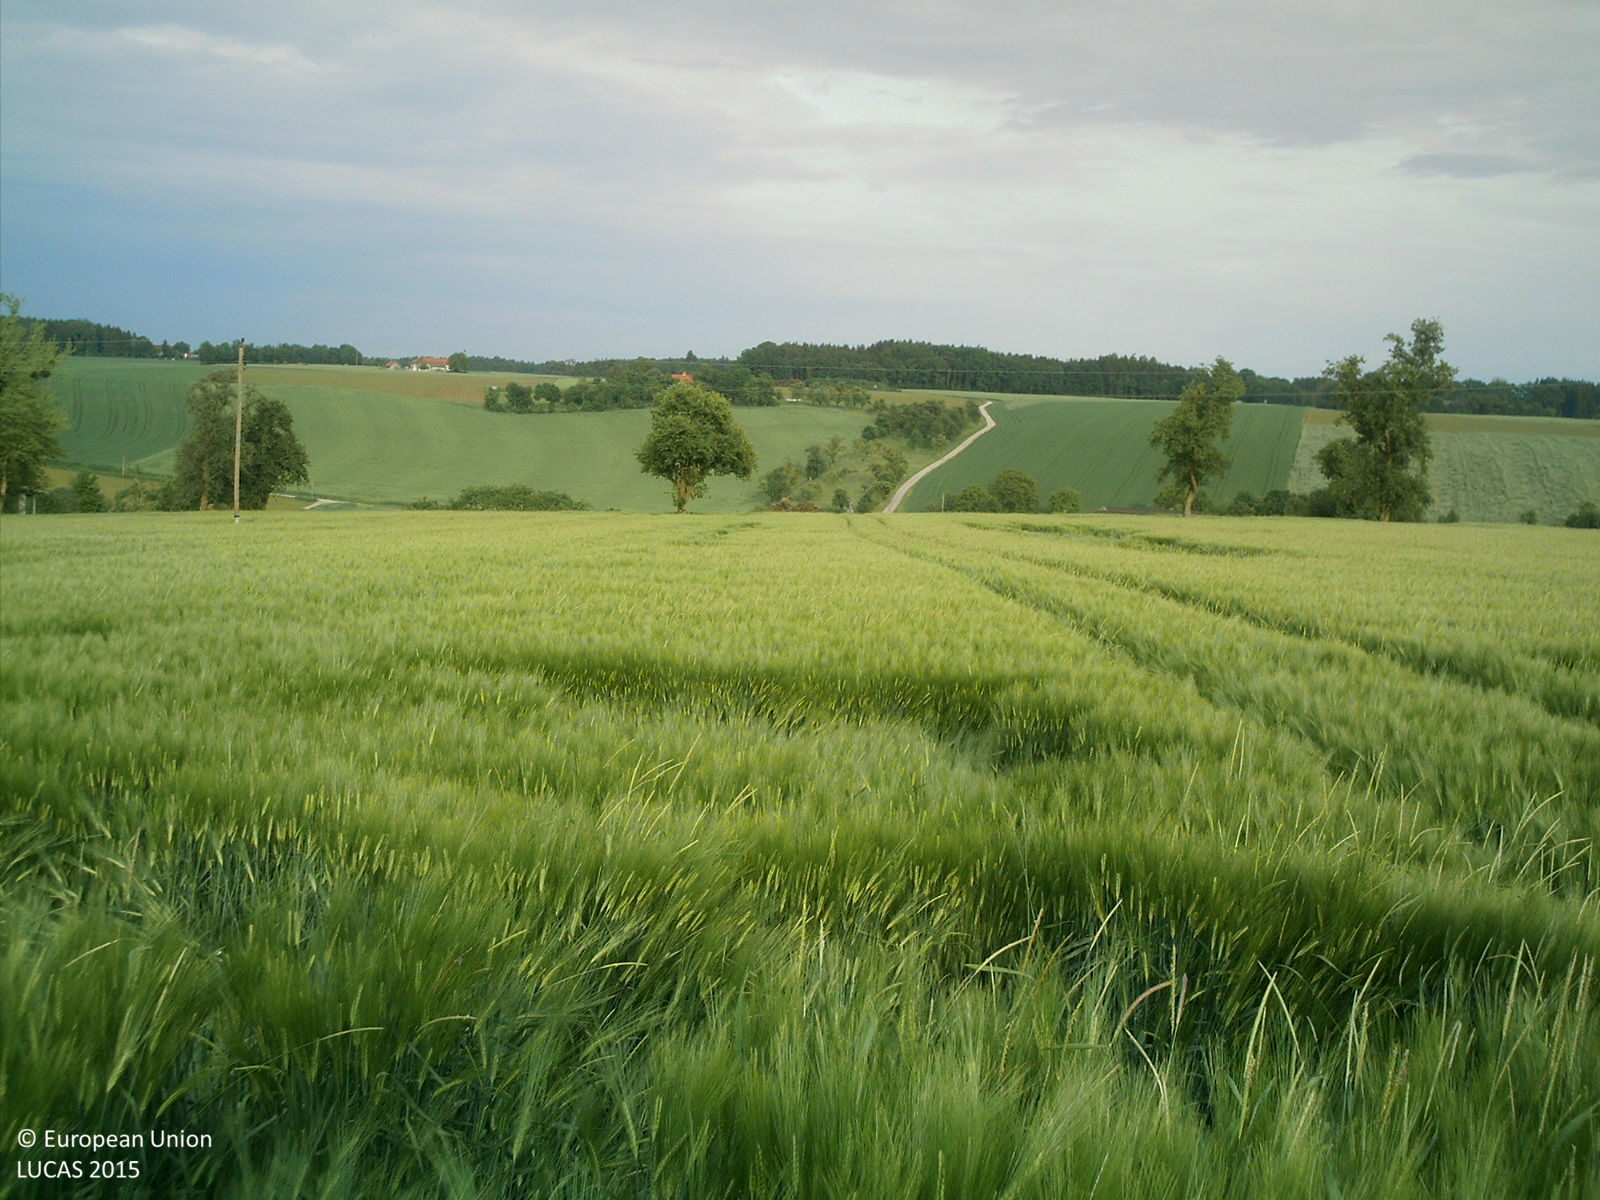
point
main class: Cropland
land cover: Barley
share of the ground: > 75 %
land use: Agriculture (excluding fallow land and kitchen gardens)
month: May
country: AT
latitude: 48.1623
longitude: 14.1811
